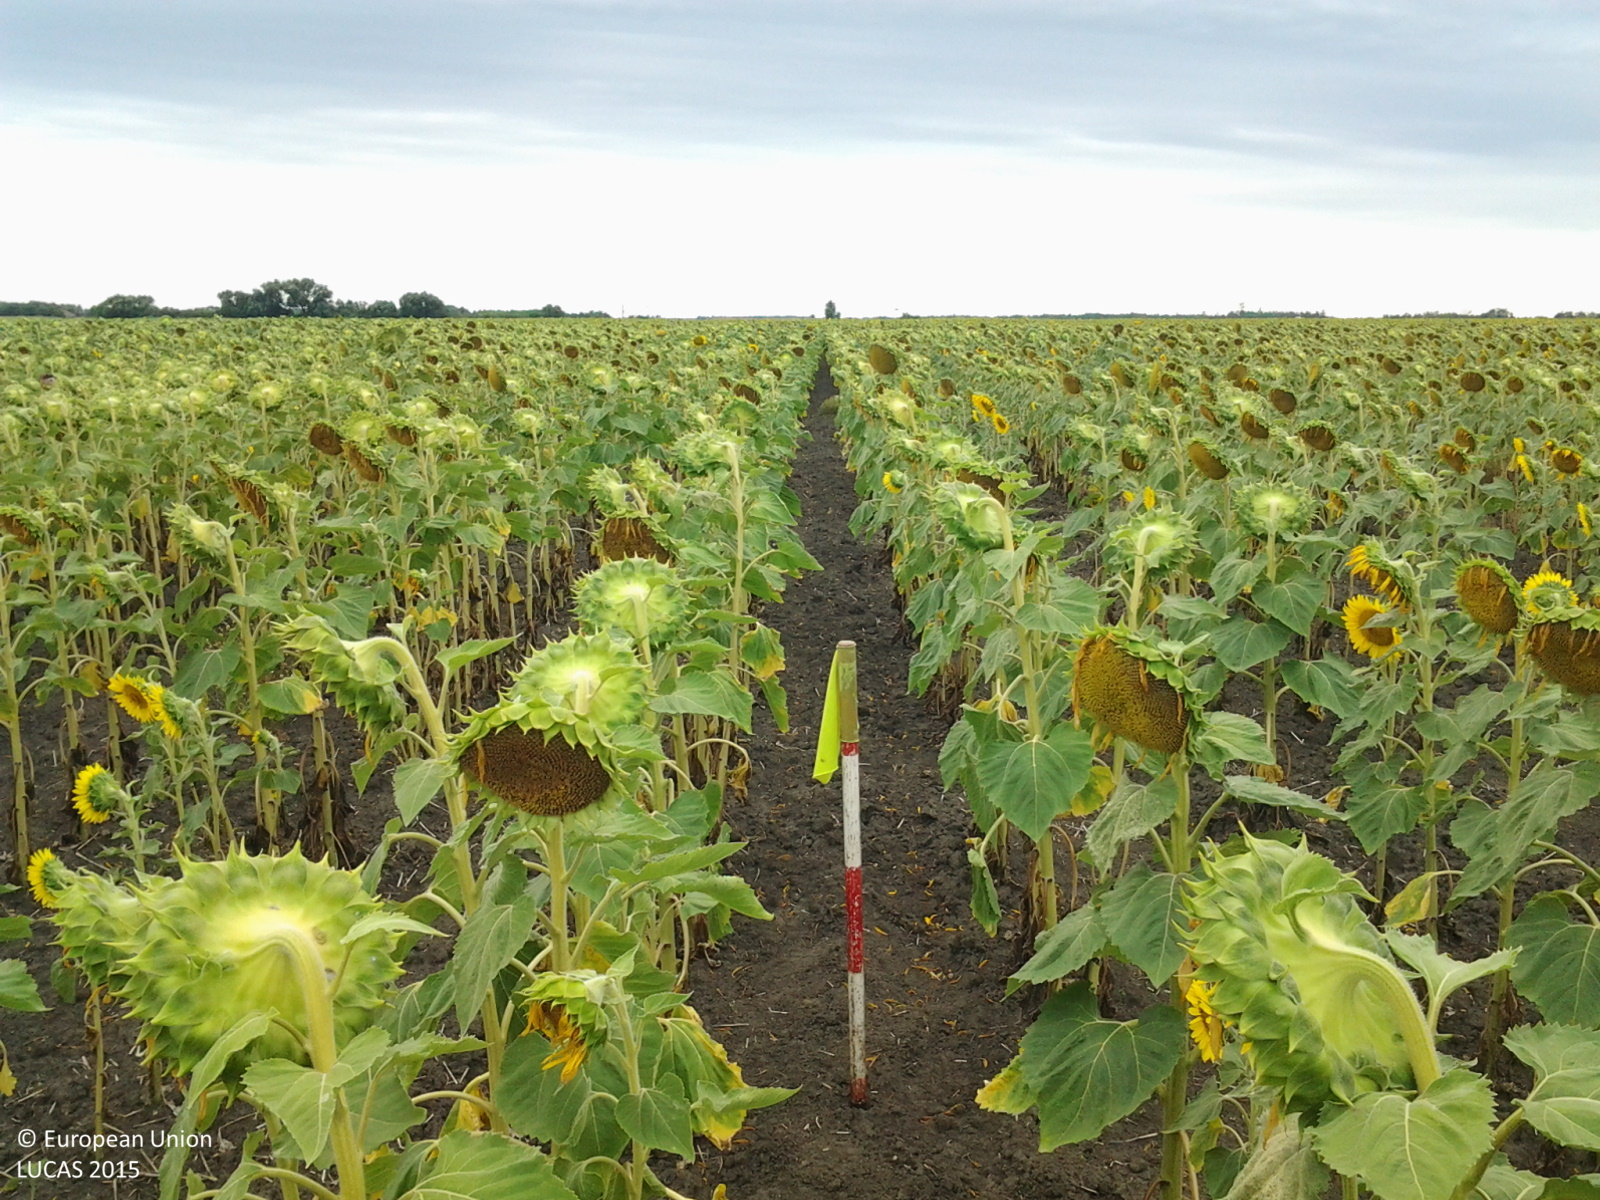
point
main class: Cropland
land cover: Sunflower
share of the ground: > 75 %
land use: Agriculture (excluding fallow land and kitchen gardens)
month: July
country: HU
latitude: 47.1363
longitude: 20.5380
